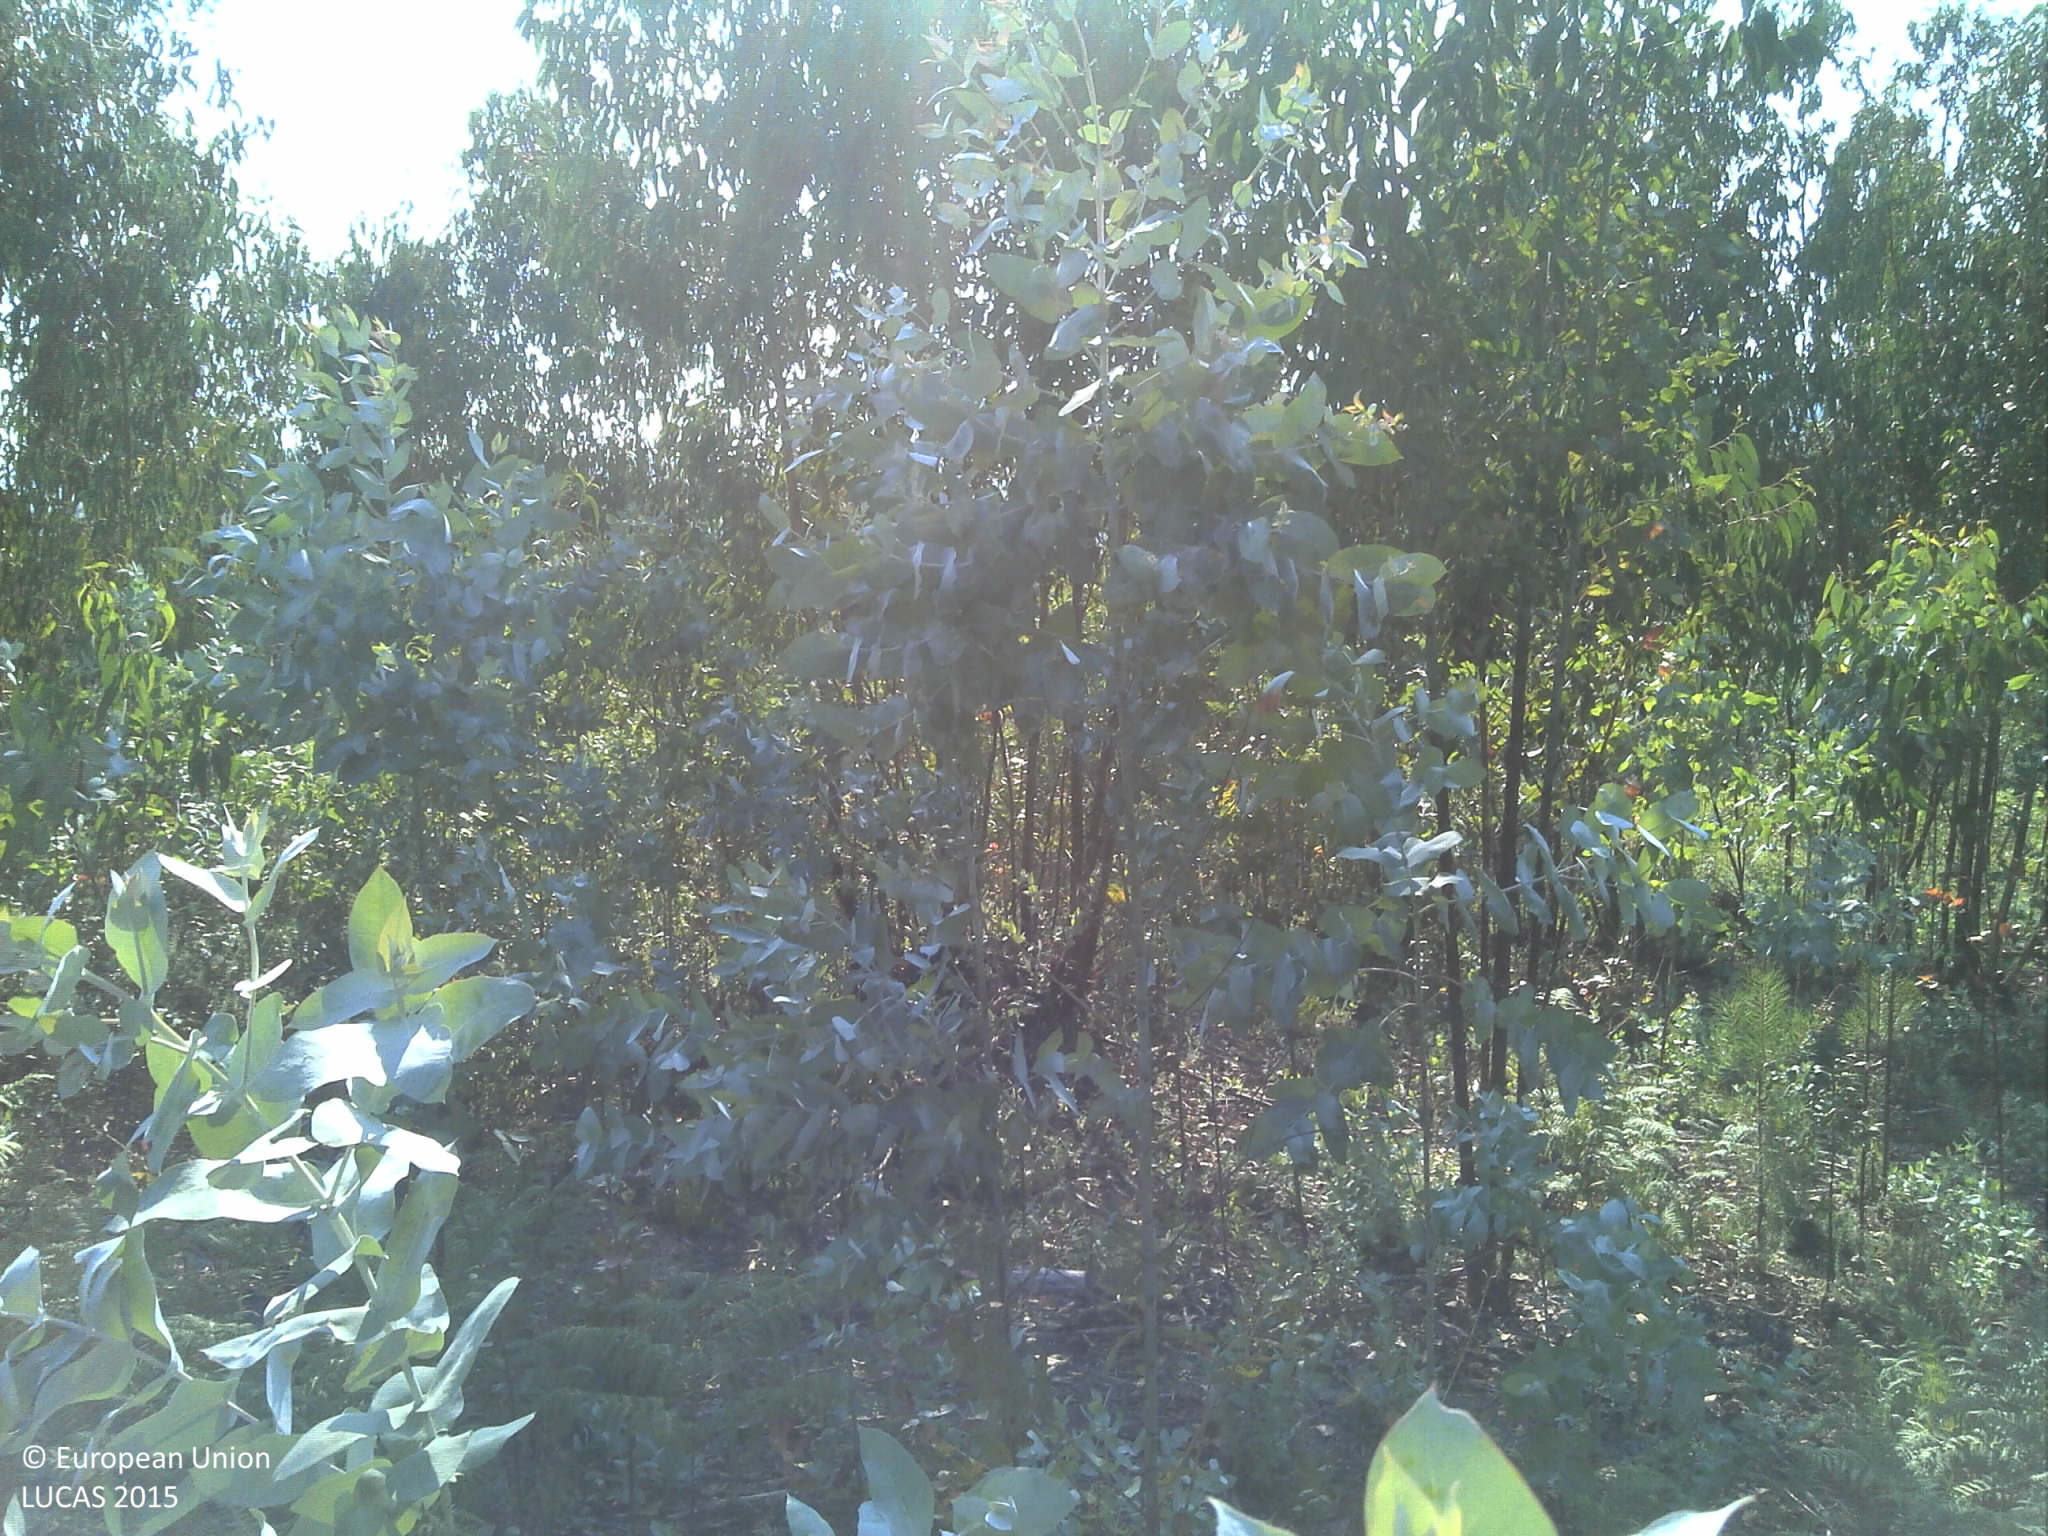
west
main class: Woodland
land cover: Broadleaved woodland
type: exotic forest
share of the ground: 50 - 75 %
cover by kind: broadleaved forest trees 60 %, shrubs 20 %, unconsolidated bare surface 20 %
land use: Forestry
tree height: < 5 m
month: June
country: PT
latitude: 40.6221
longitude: -8.0849
